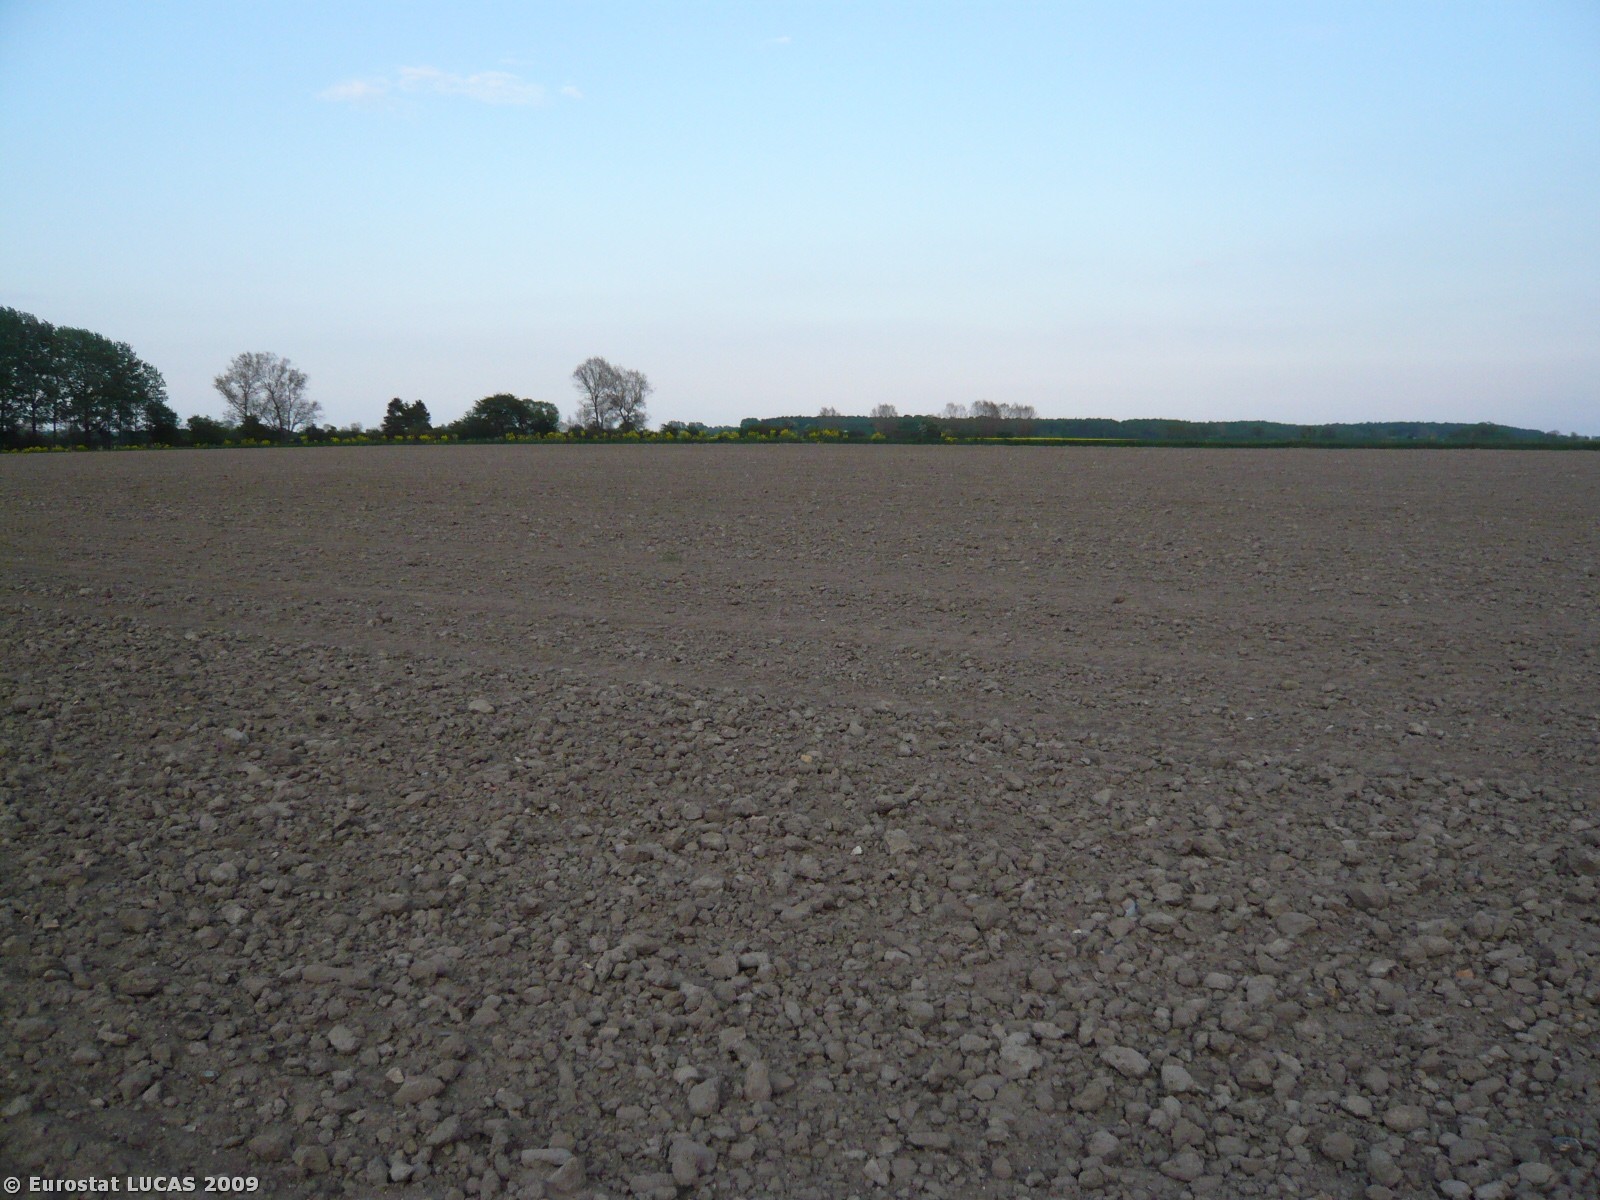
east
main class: Cropland
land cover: Other root crops
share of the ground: < 10 %
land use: Agriculture (excluding fallow land and kitchen gardens)
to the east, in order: Other root crops; Common wheat
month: May
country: DK
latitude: 55.3223
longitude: 12.2835
